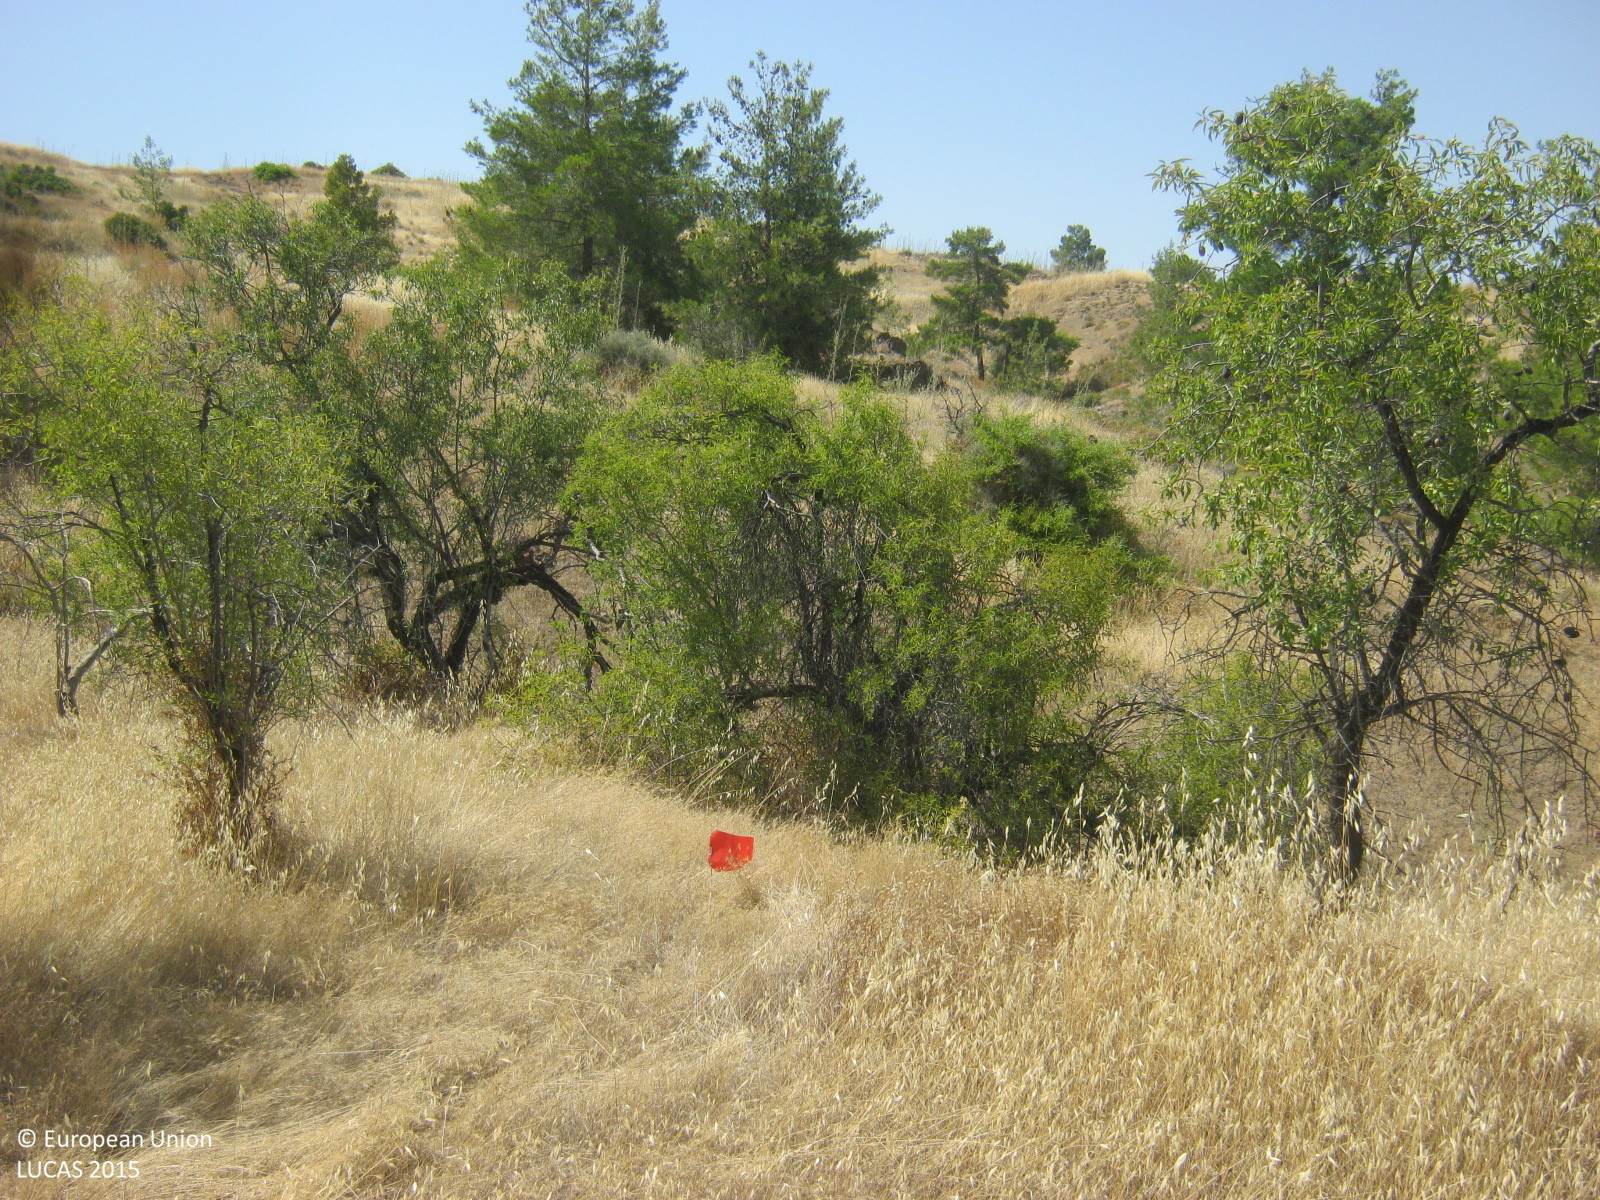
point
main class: Cropland
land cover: Nuts trees
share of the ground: 25 - 50 %
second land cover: Grassland without tree/shrub cover
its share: > 75 %
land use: Agriculture (excluding fallow land and kitchen gardens)
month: June
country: CY
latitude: 35.0530
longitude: 33.0138
